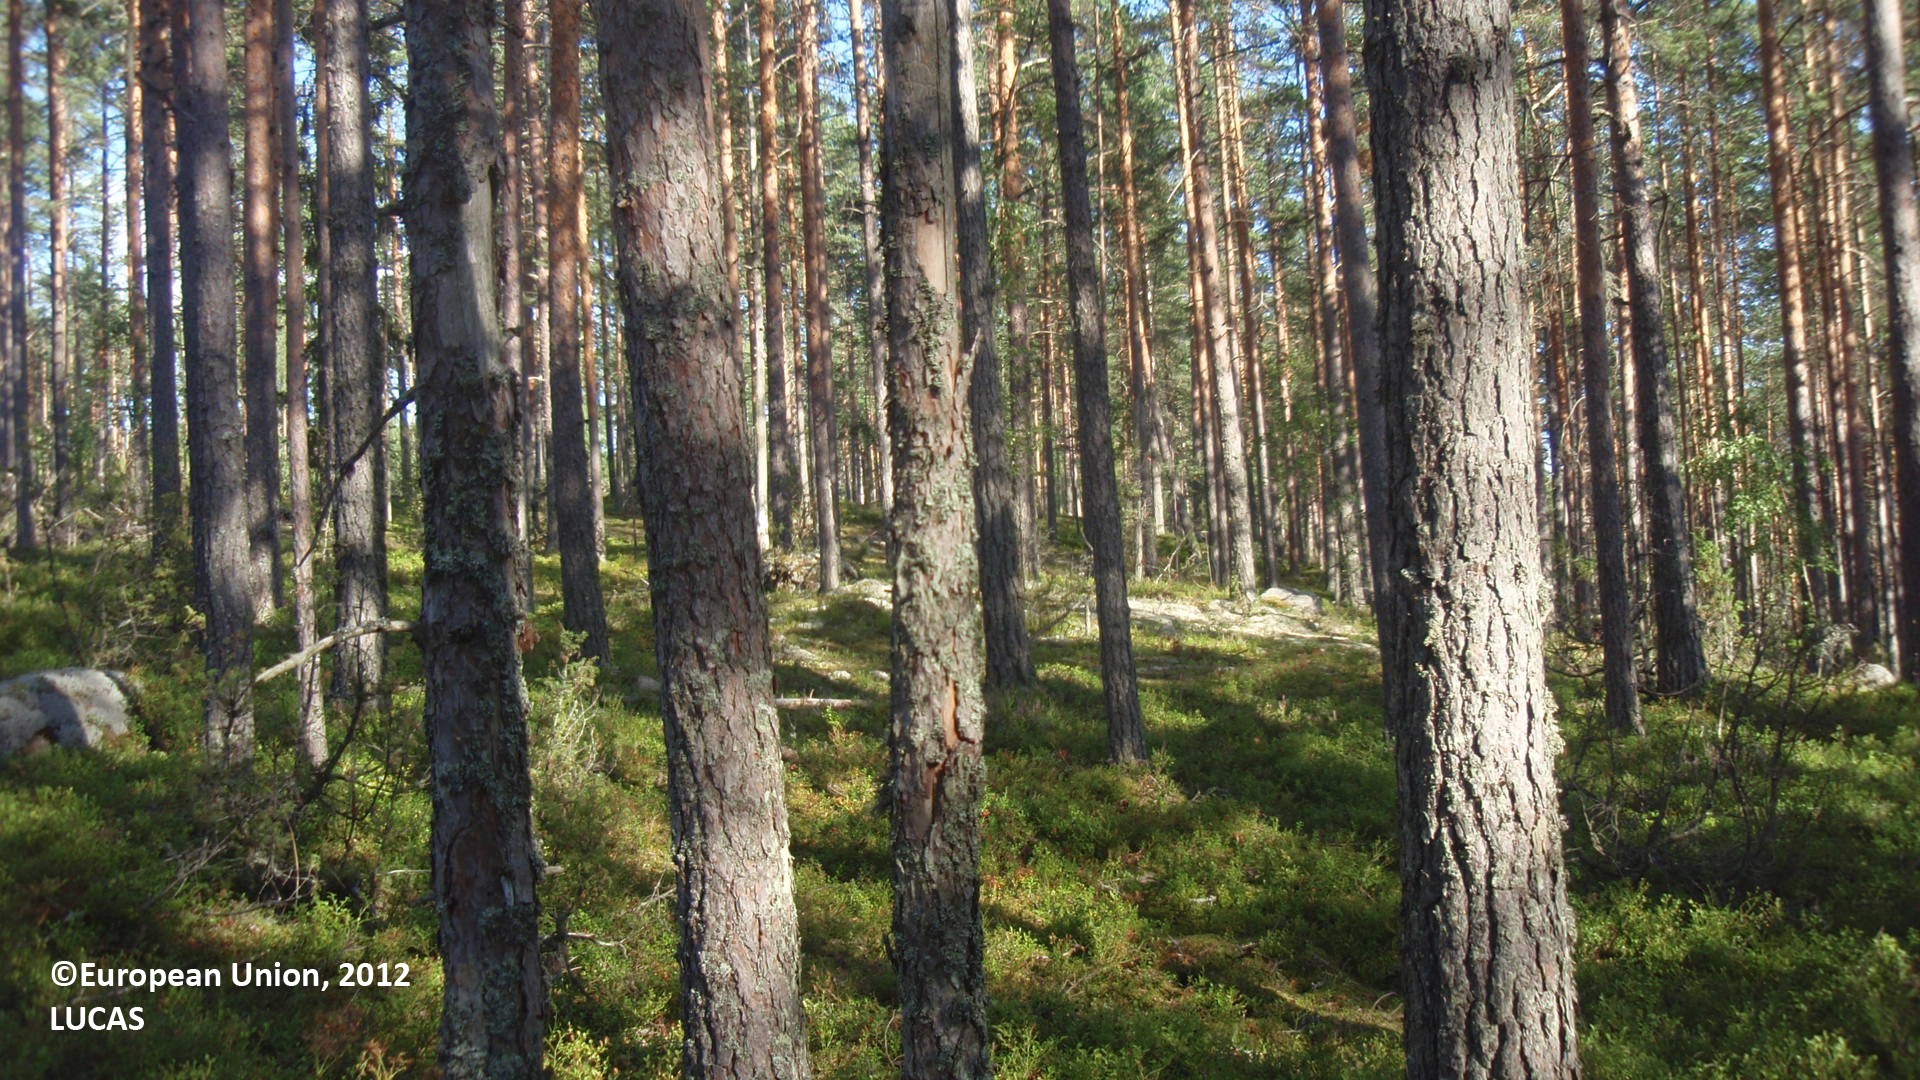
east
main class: Woodland
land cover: Pine dominated coniferous woodland
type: boreal forest
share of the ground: 50 - 75 %
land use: Forestry
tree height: > 5 m
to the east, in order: Pine dominated coniferous woodland; Shrubland with sparse tree cover; Pine dominated coniferous woodland
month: August
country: FI
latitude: 61.5578
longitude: 27.7846
